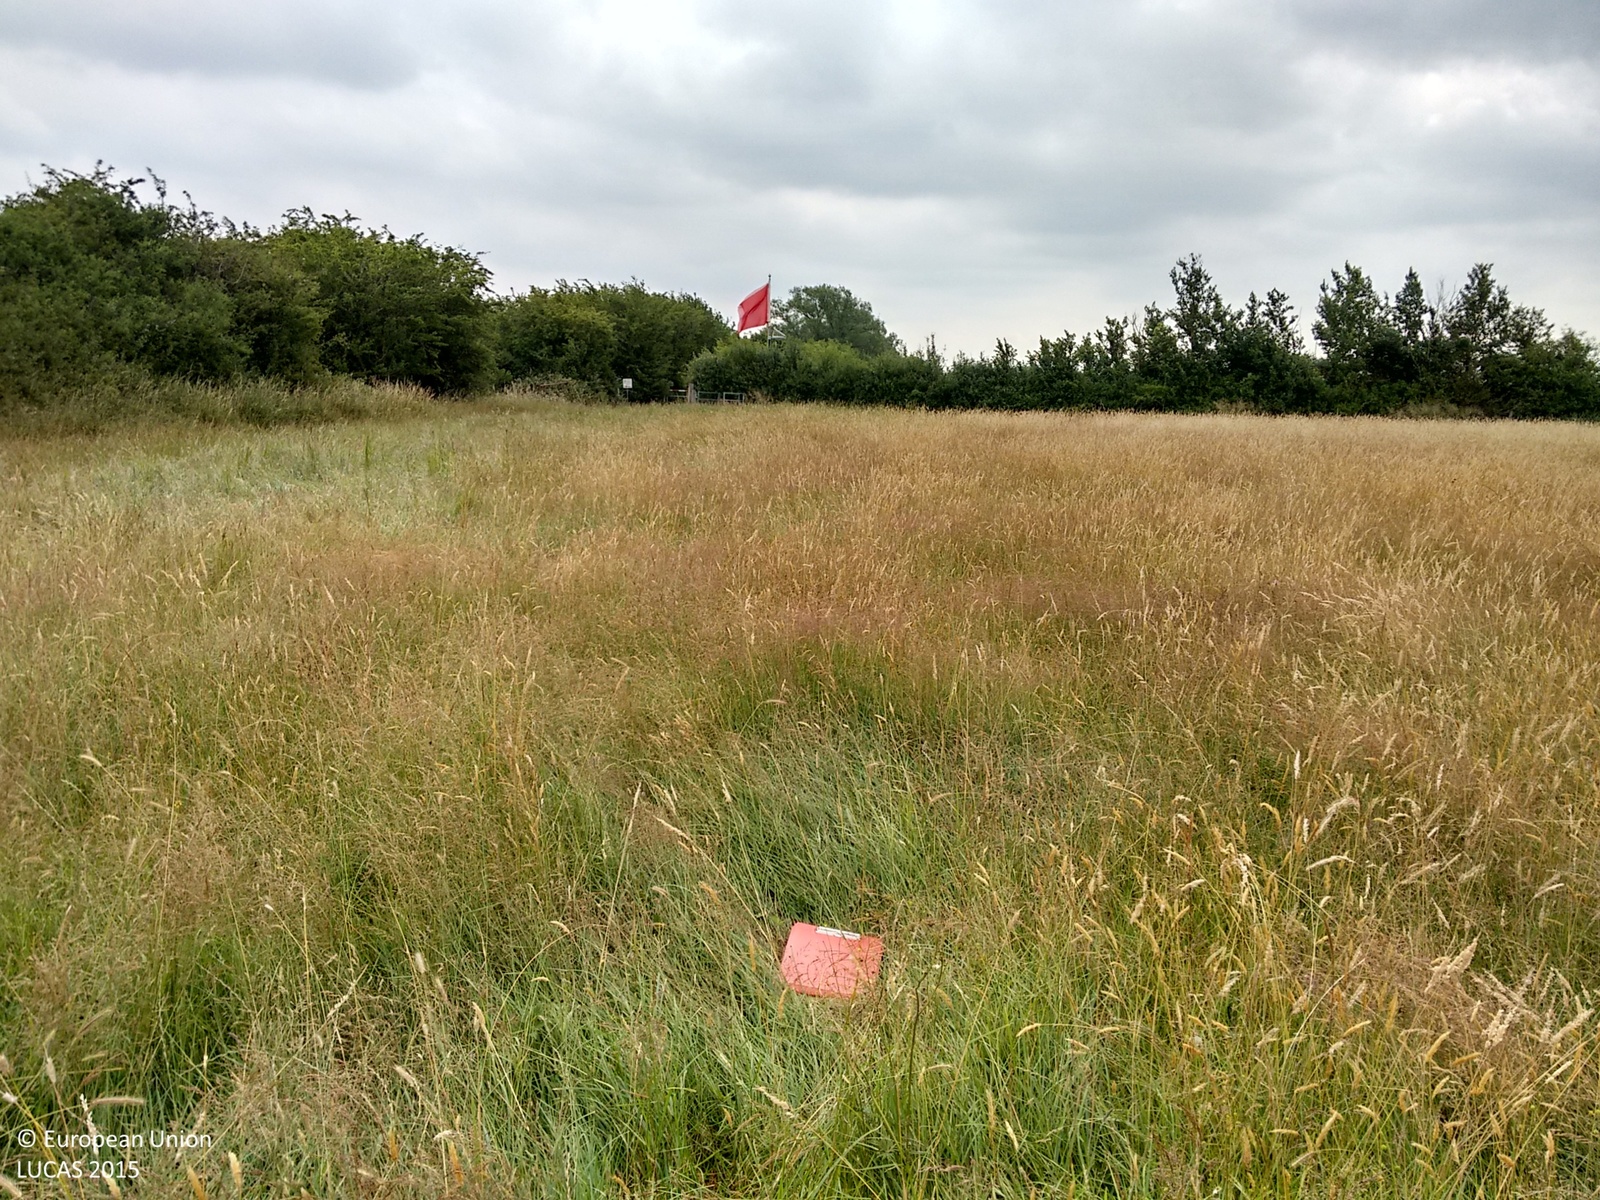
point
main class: Grassland
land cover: Grassland without tree/shrub cover
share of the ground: > 75 %
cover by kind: herbaceous plants 100 %
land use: Agriculture (excluding fallow land and kitchen gardens)
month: July
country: GB
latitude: 51.8297
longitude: -1.1764
